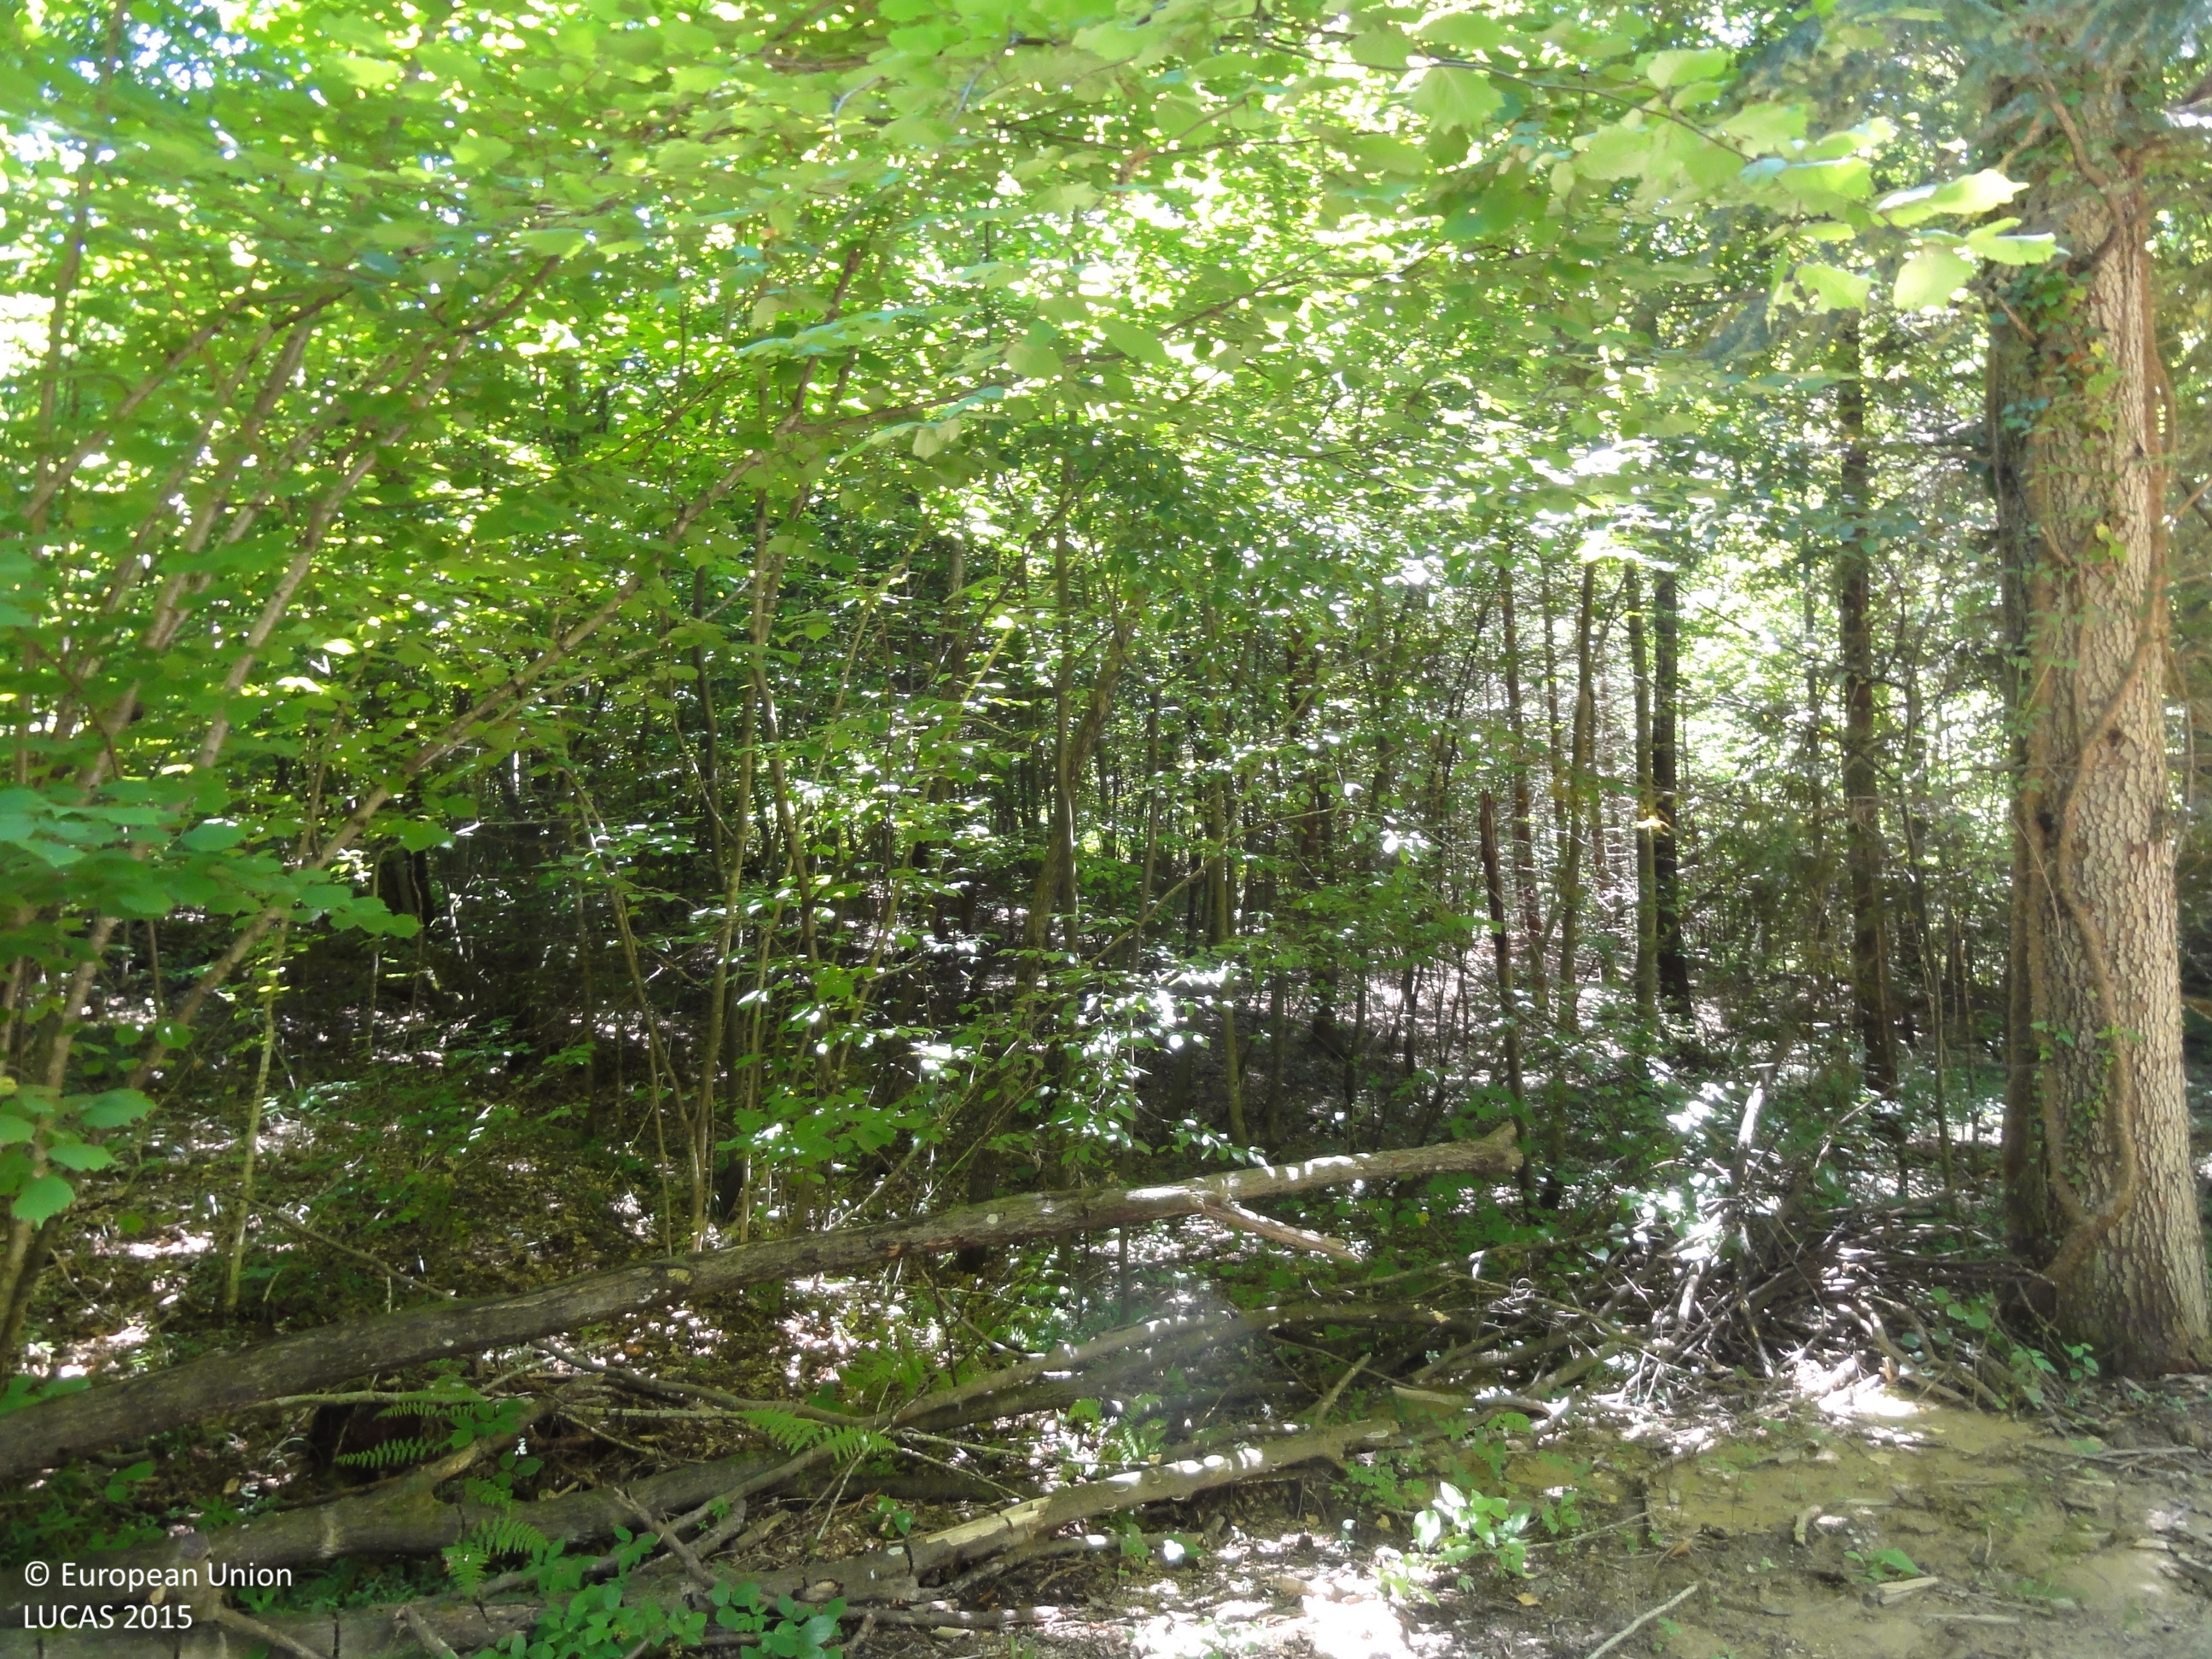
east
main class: Woodland
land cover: Spruce dominated mixed woodland
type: mountainous beech forest
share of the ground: > 75 %
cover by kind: coniferous forest trees 60 %, broadleaved forest trees 35 %, unconsolidated bare surface 5 %
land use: Forestry
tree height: > 5 m
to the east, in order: Tracks; Spruce dominated mixed woodland; Tracks; Spruce dominated mixed woodland; Shrubland with sparse tree cover; Spruce dominated mixed woodland; Broadleaved woodland; Rivers and streams; Broadleaved woodland; Spruce dominated mixed woodland; Ditches and canals; Spruce dominated mixed woodland; Tracks; Spruce dominated mixed woodland; Tracks; Spruce dominated mixed woodland; Other mixed woodland
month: July
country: SI
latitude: 46.3030
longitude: 15.0741
